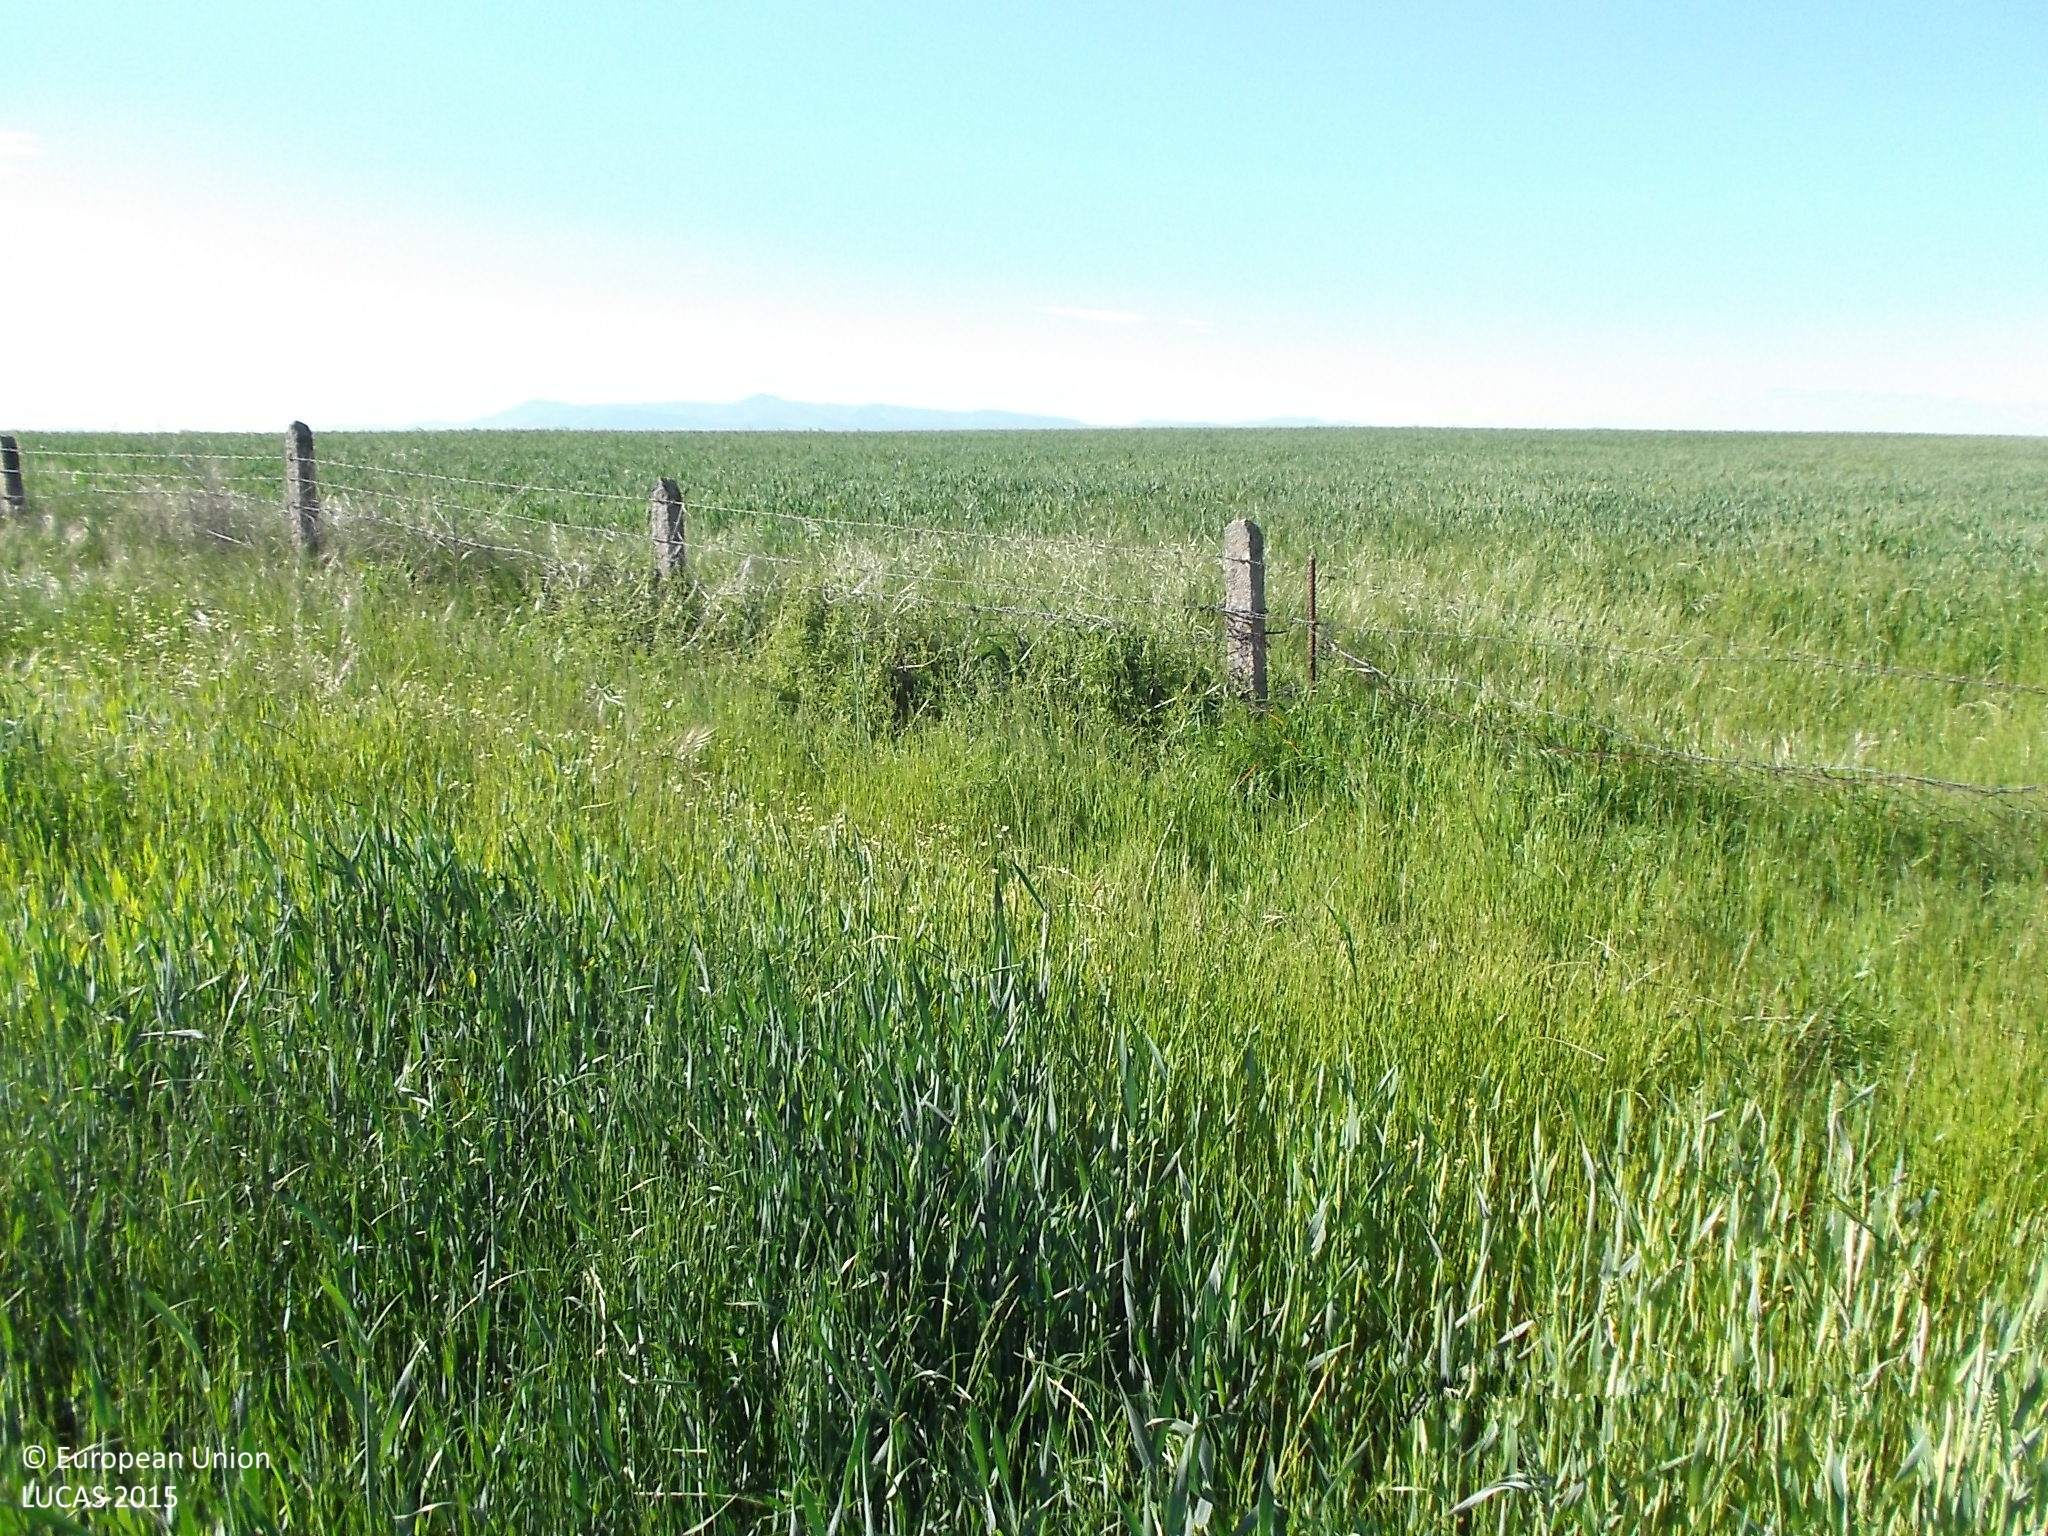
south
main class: Cropland
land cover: Mixed cereals for fodder
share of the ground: > 75 %
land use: Agriculture (excluding fallow land and kitchen gardens)
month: May
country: ES
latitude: 40.7956
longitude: -6.2650
